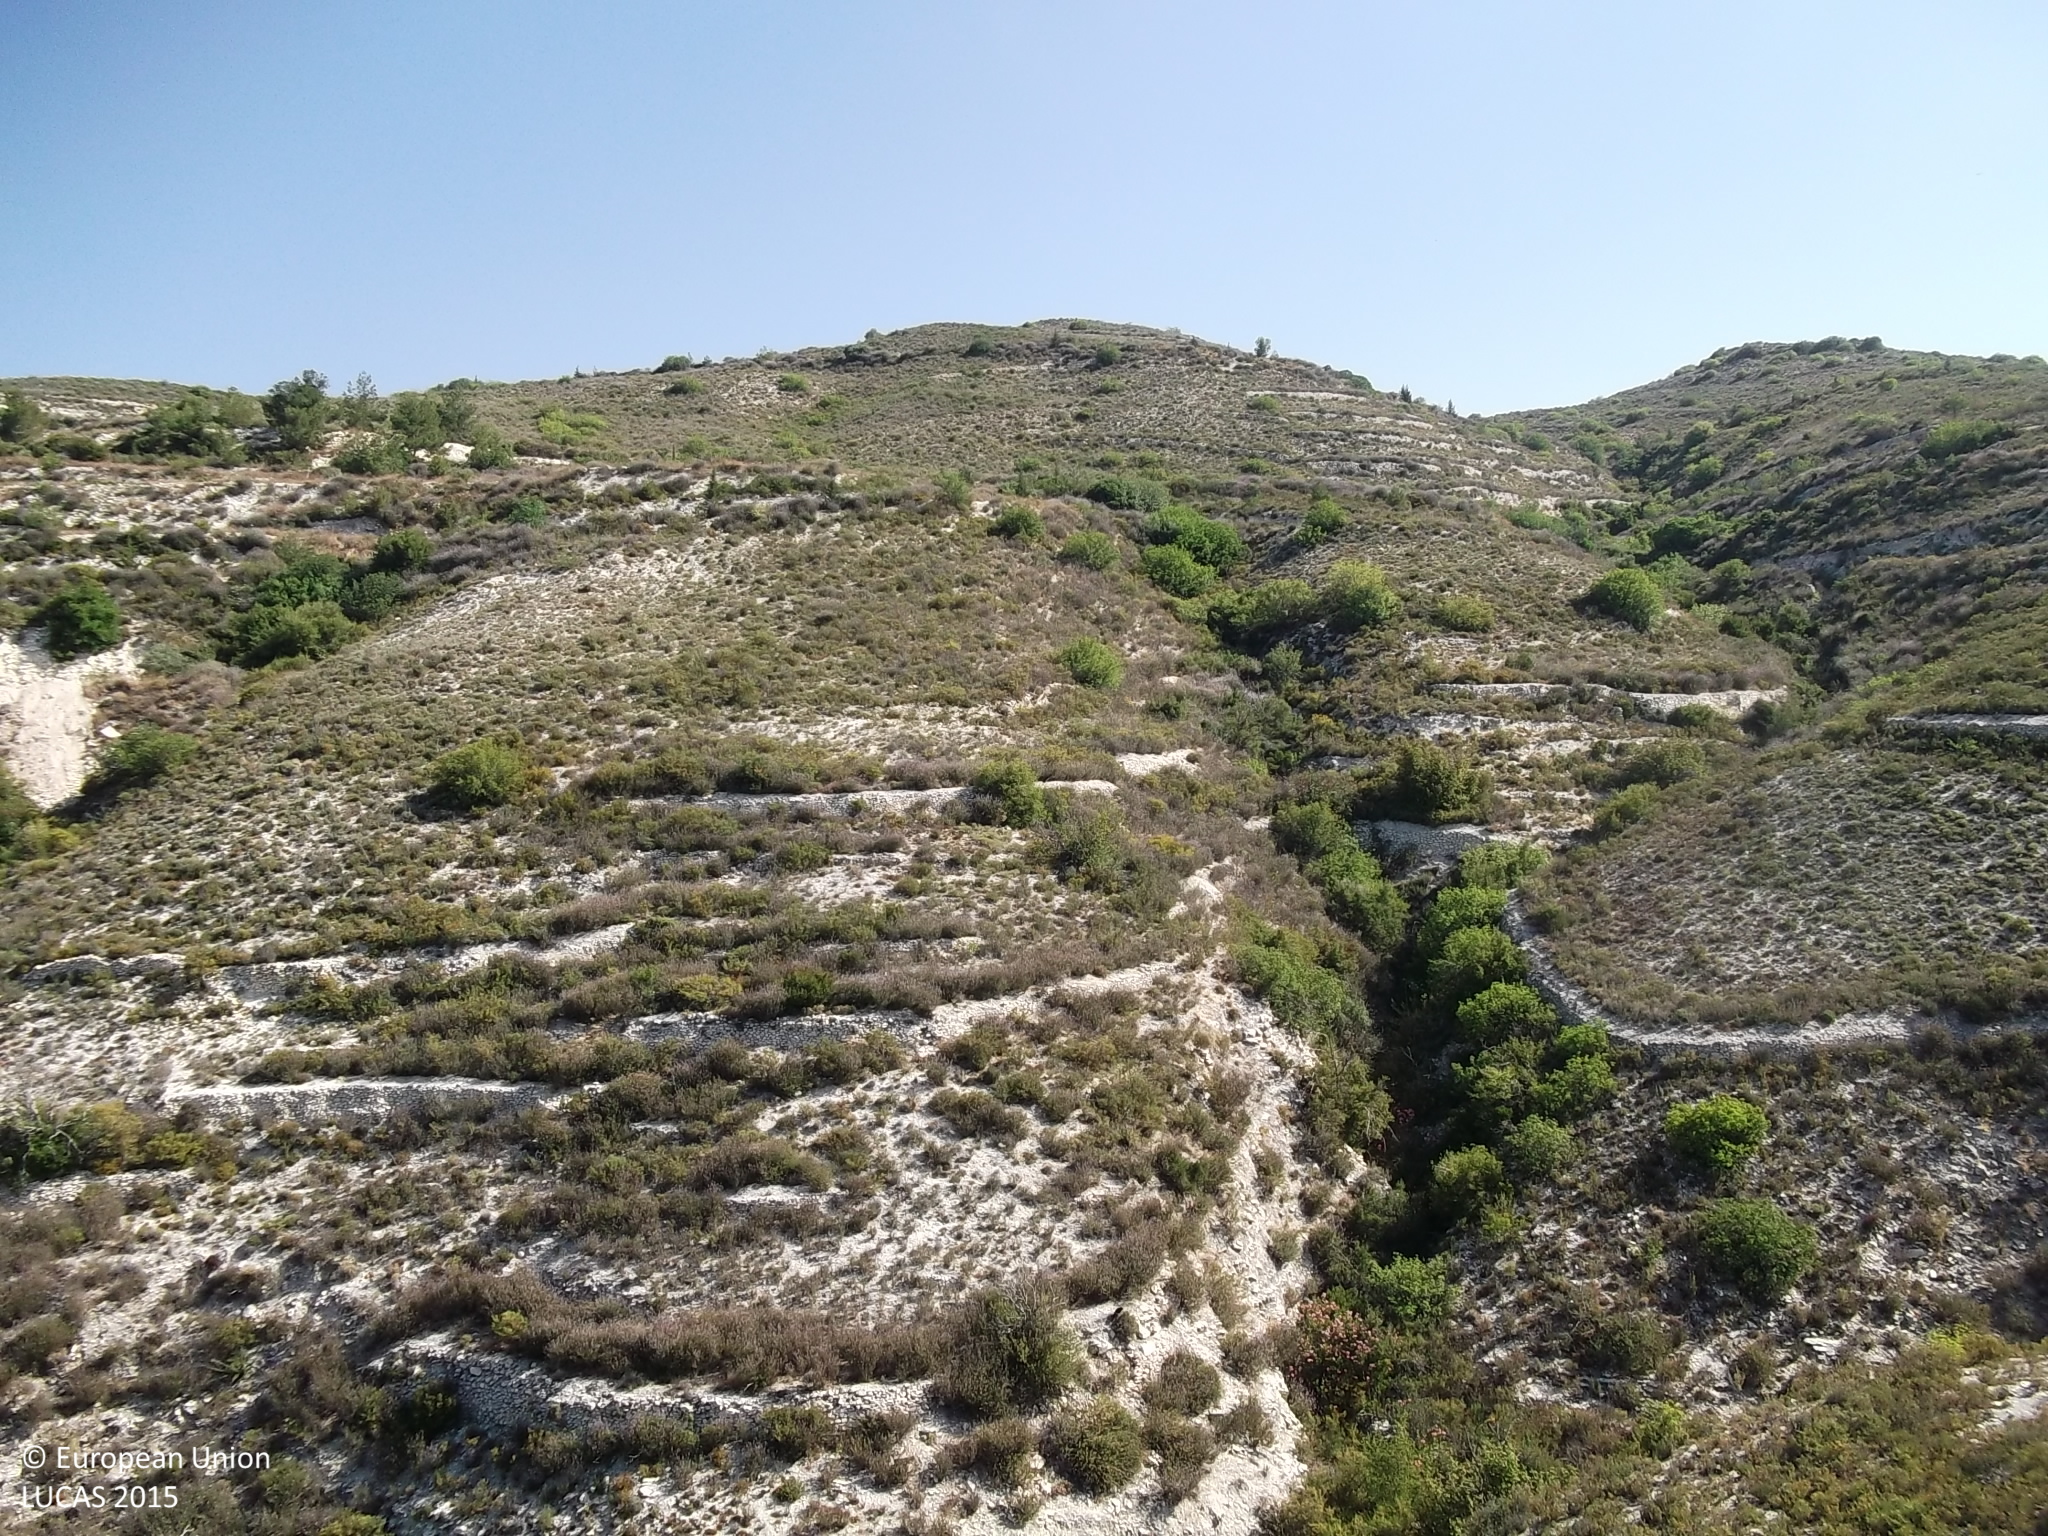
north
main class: Shrubland
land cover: Shrubland without tree cover
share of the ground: 25 - 50 %
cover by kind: shrubs 50 %, unconsolidated bare surface 40 %, consolidated bare surface 10 %
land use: Semi-natural and natural areas not in use
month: June
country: CY
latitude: 34.8331
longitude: 32.9201
